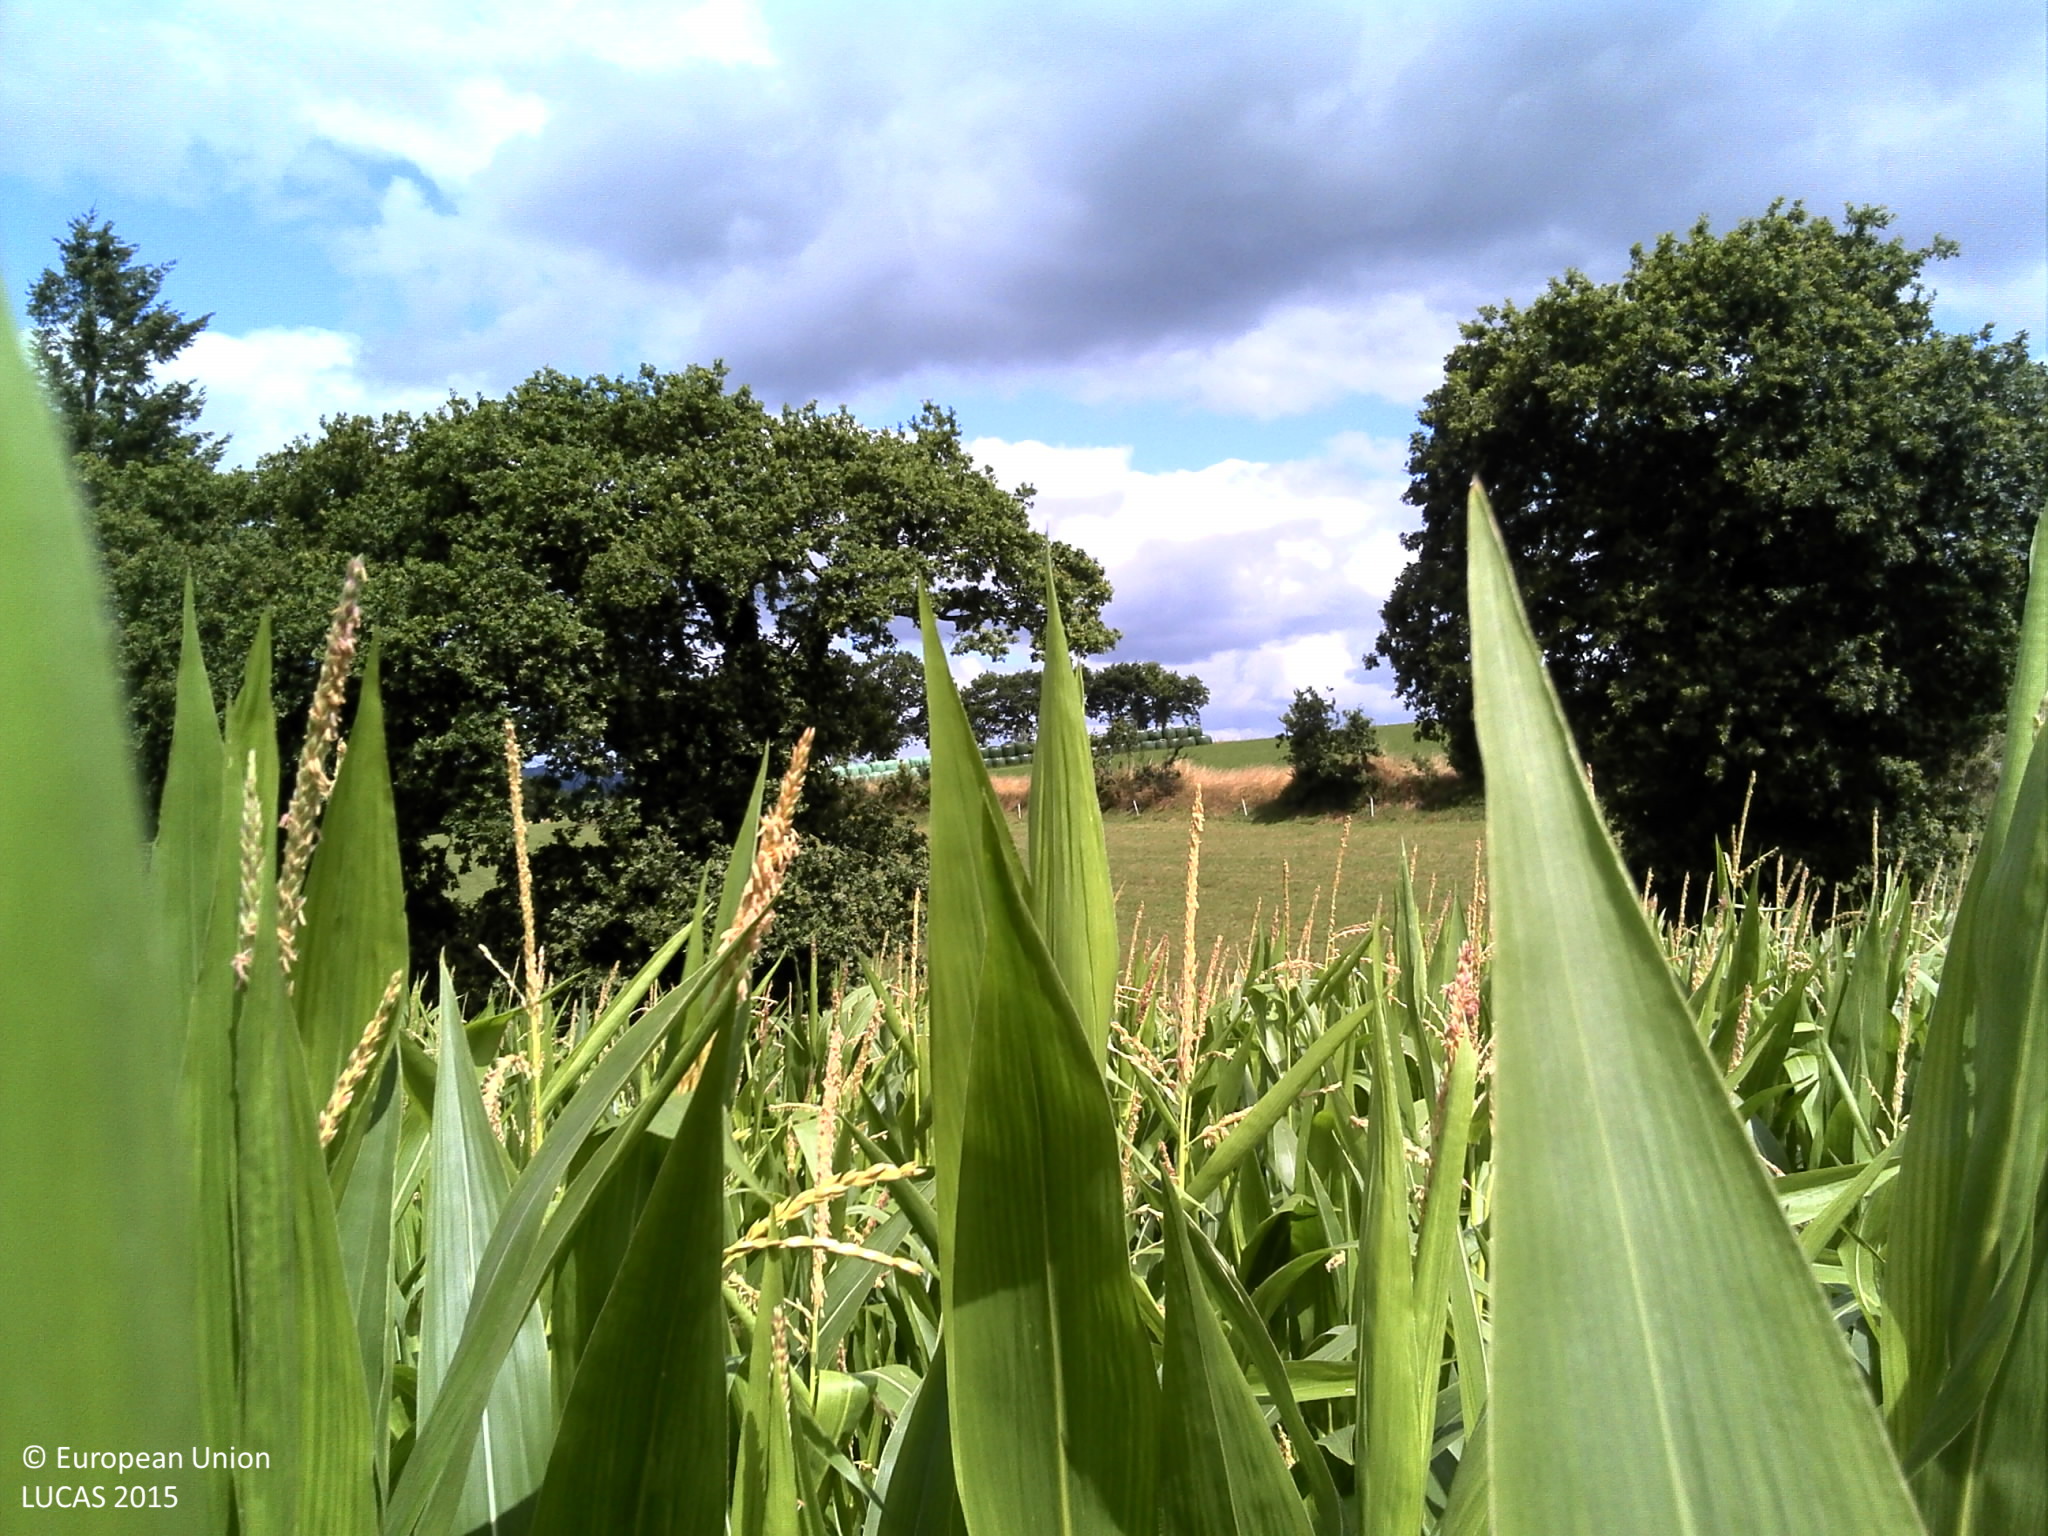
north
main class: Cropland
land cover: Maize
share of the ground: > 75 %
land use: Agriculture (excluding fallow land and kitchen gardens)
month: July
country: FR
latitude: 48.2927
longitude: -3.7092
